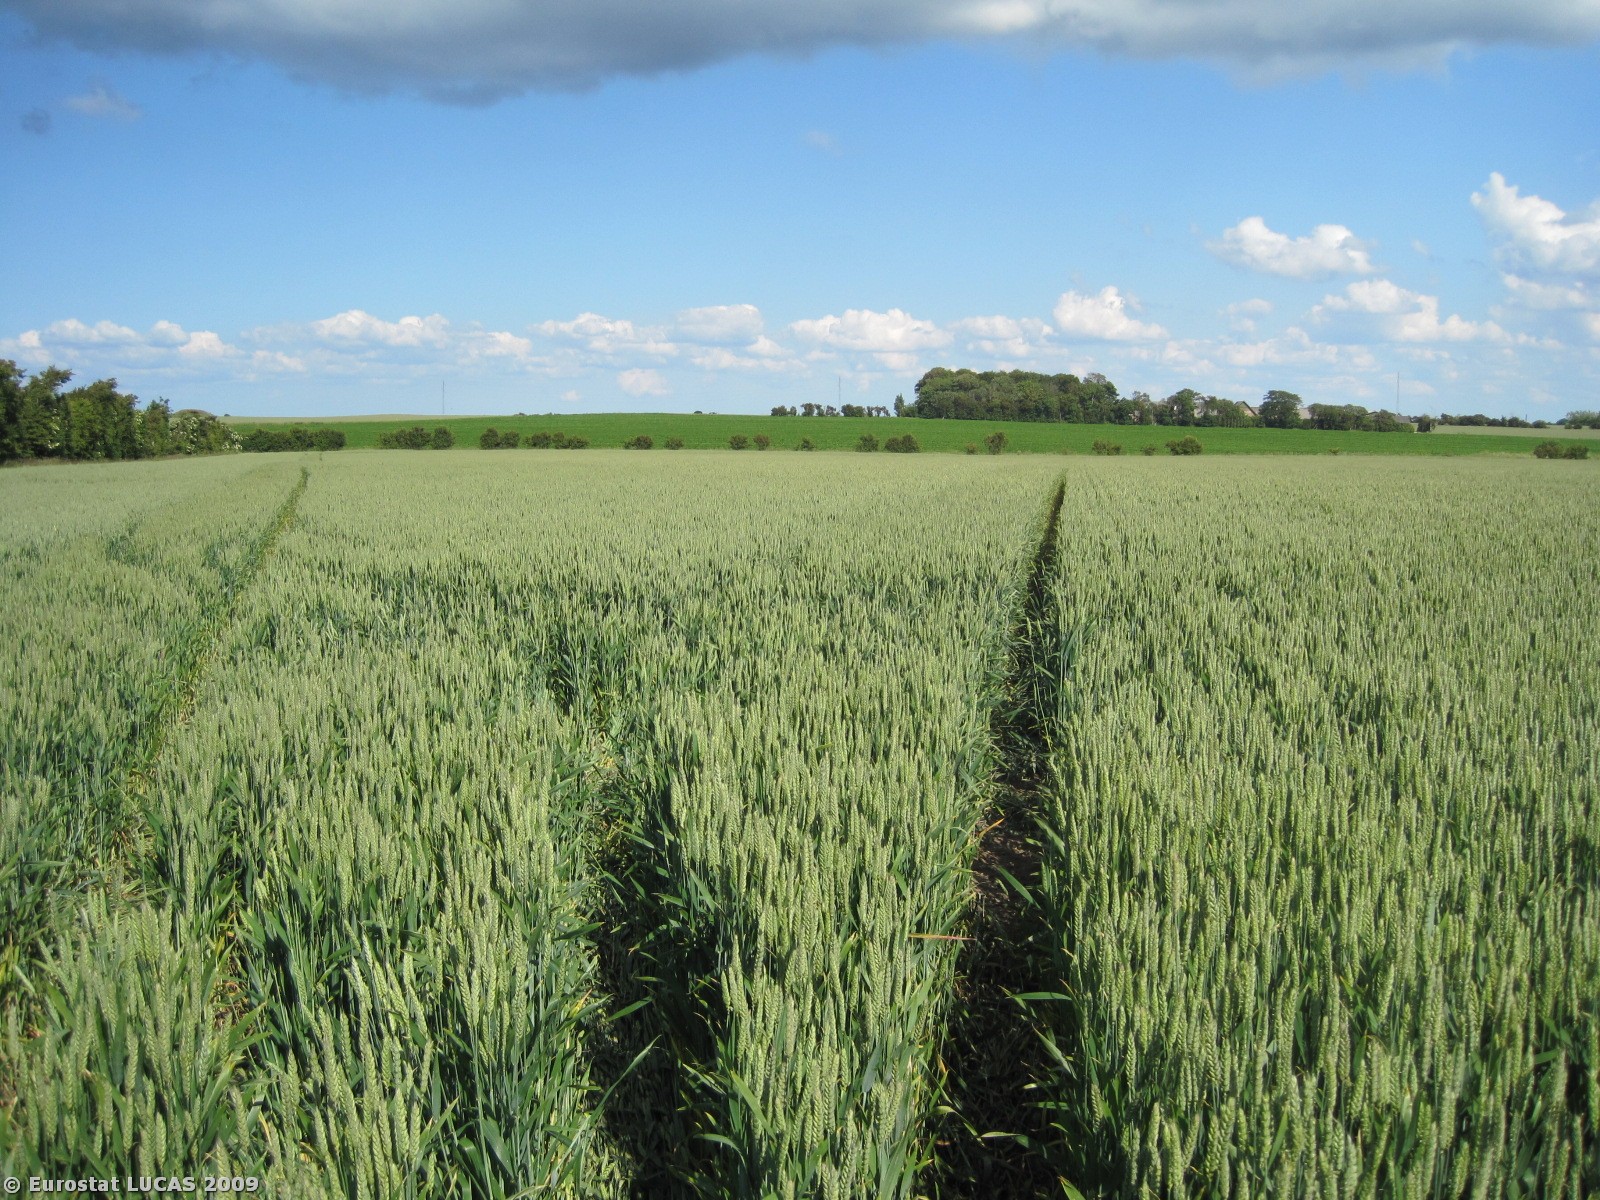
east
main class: Cropland
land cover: Common wheat
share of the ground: > 75 %
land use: Agriculture (excluding fallow land and kitchen gardens)
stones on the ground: < 10 %
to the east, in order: Common wheat; Grass margins; Other fresh vegetables
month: June
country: DK
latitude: 56.5971
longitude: 8.9753
